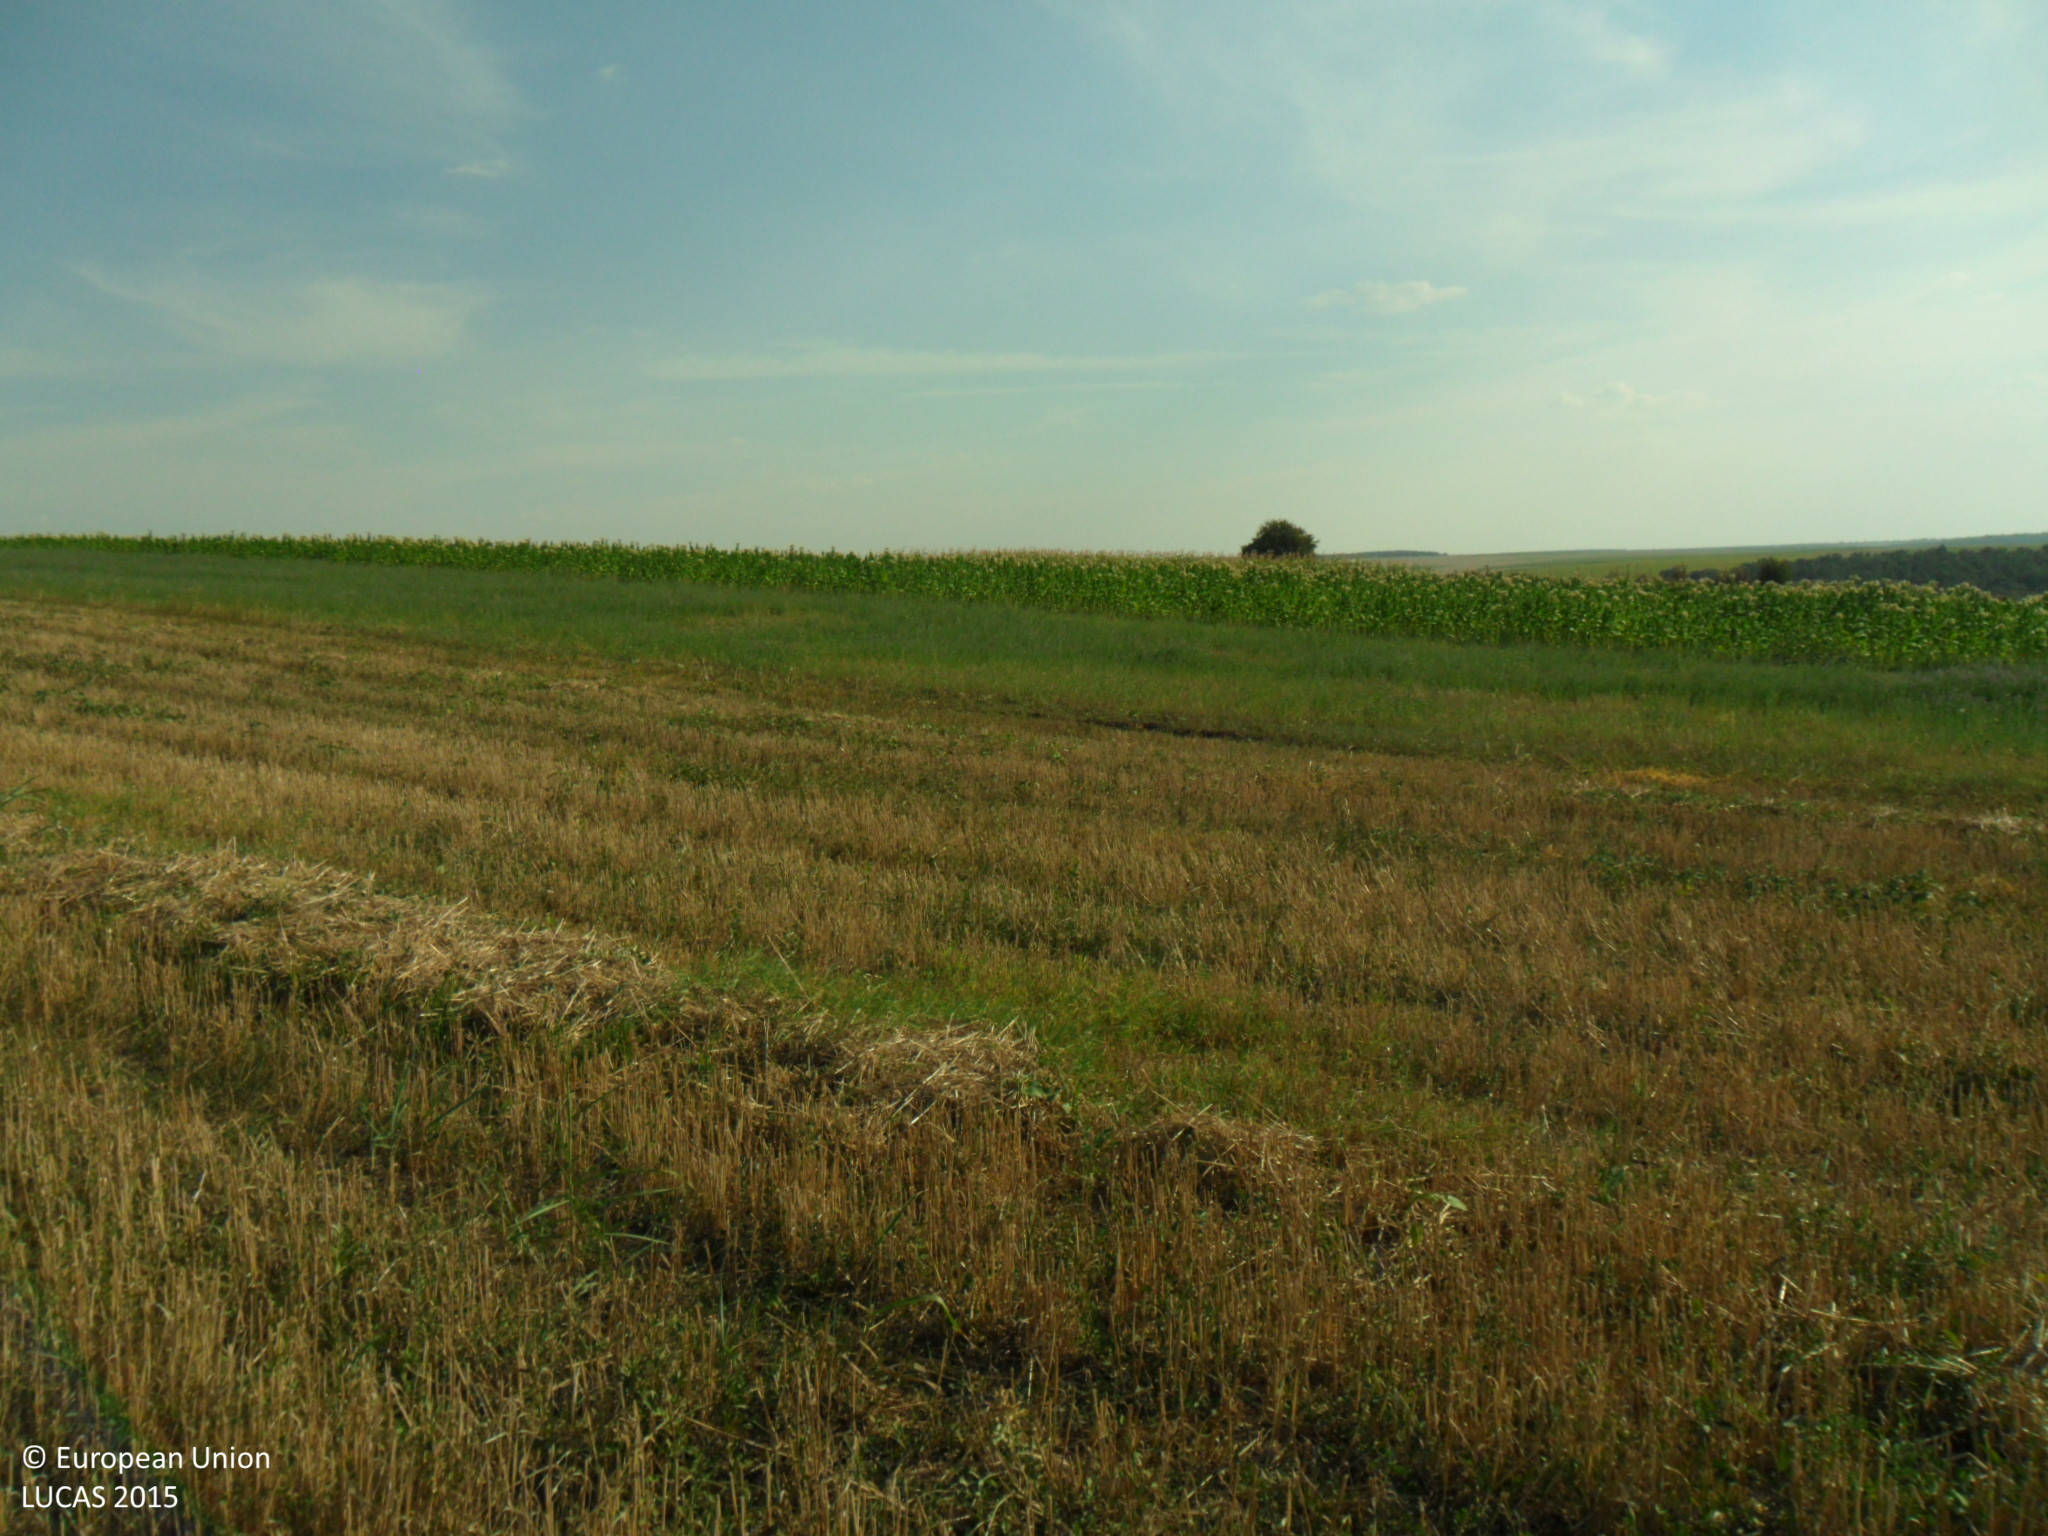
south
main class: Cropland
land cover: Barley
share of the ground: 50 - 75 %
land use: Agriculture (excluding fallow land and kitchen gardens)
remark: Harvested field
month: August
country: BG
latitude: 43.6376
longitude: 27.0911
